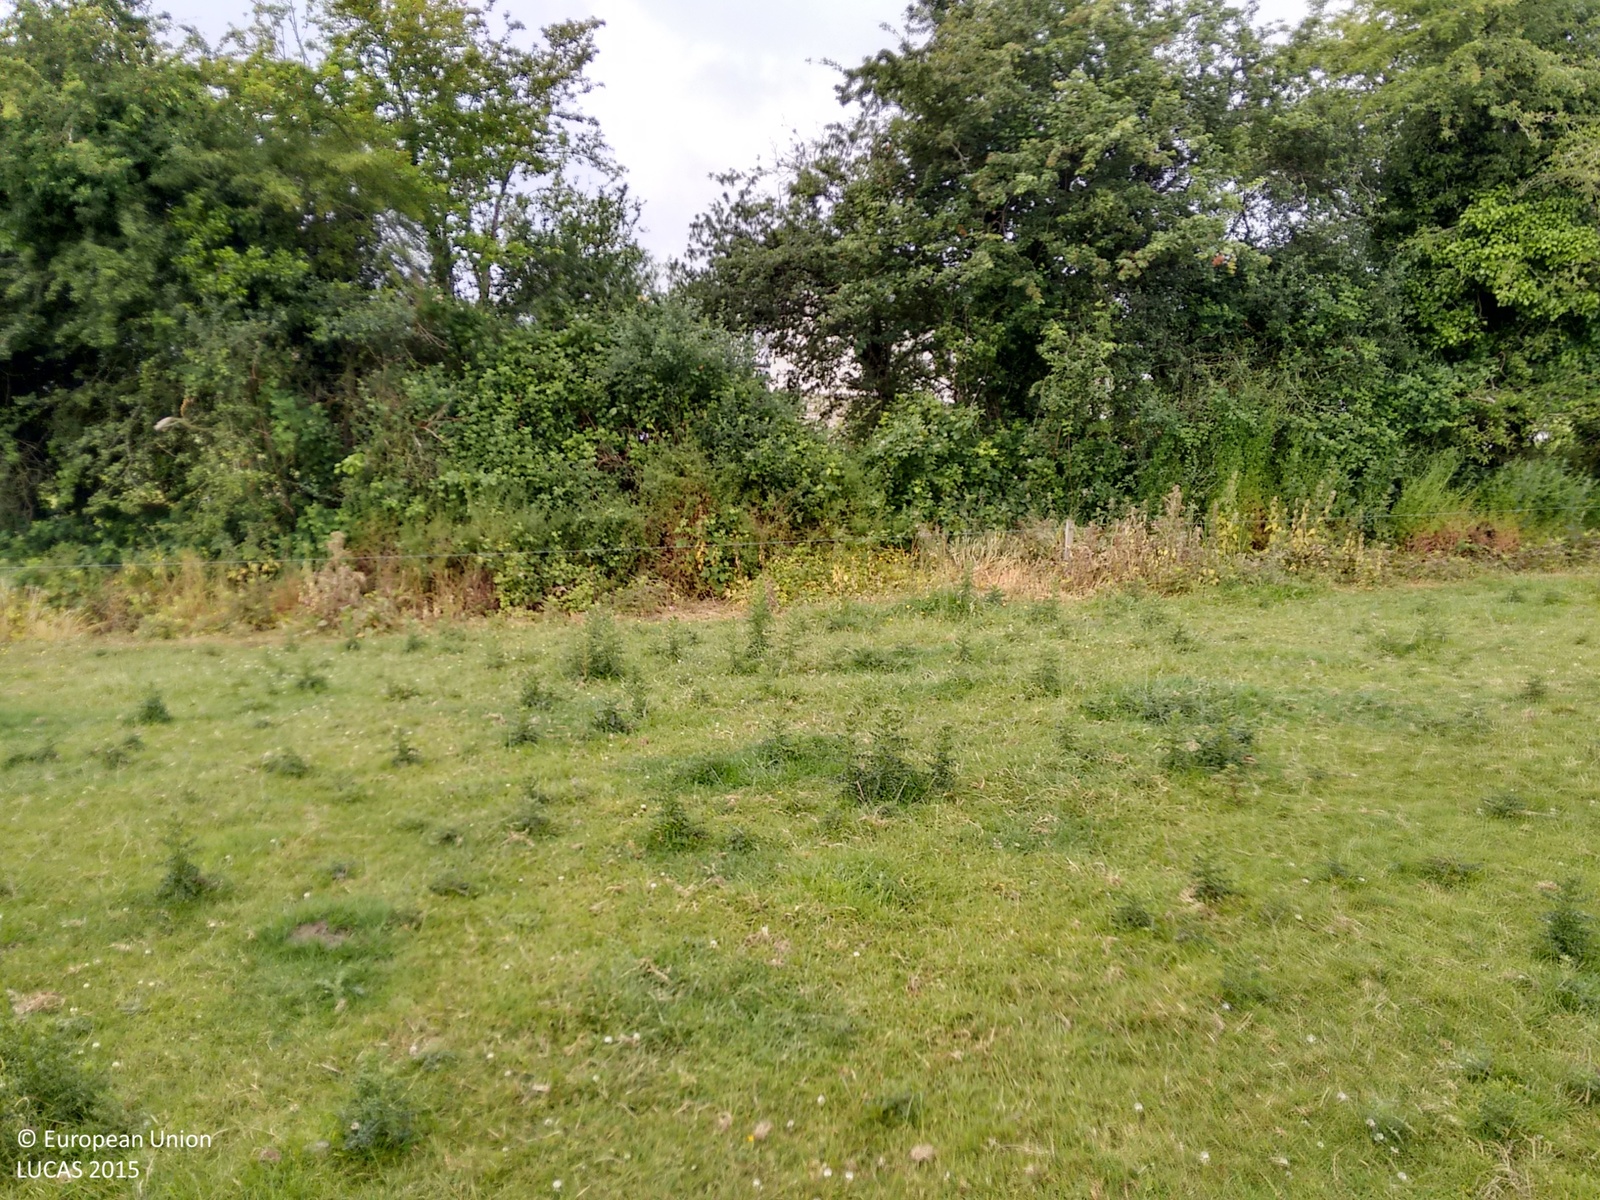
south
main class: Grassland
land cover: Grassland without tree/shrub cover
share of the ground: > 75 %
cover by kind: herbaceous plants 100 %
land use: Agriculture (excluding fallow land and kitchen gardens)
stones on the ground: < 10 %
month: June
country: IE
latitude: 52.3042
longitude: -7.3269
